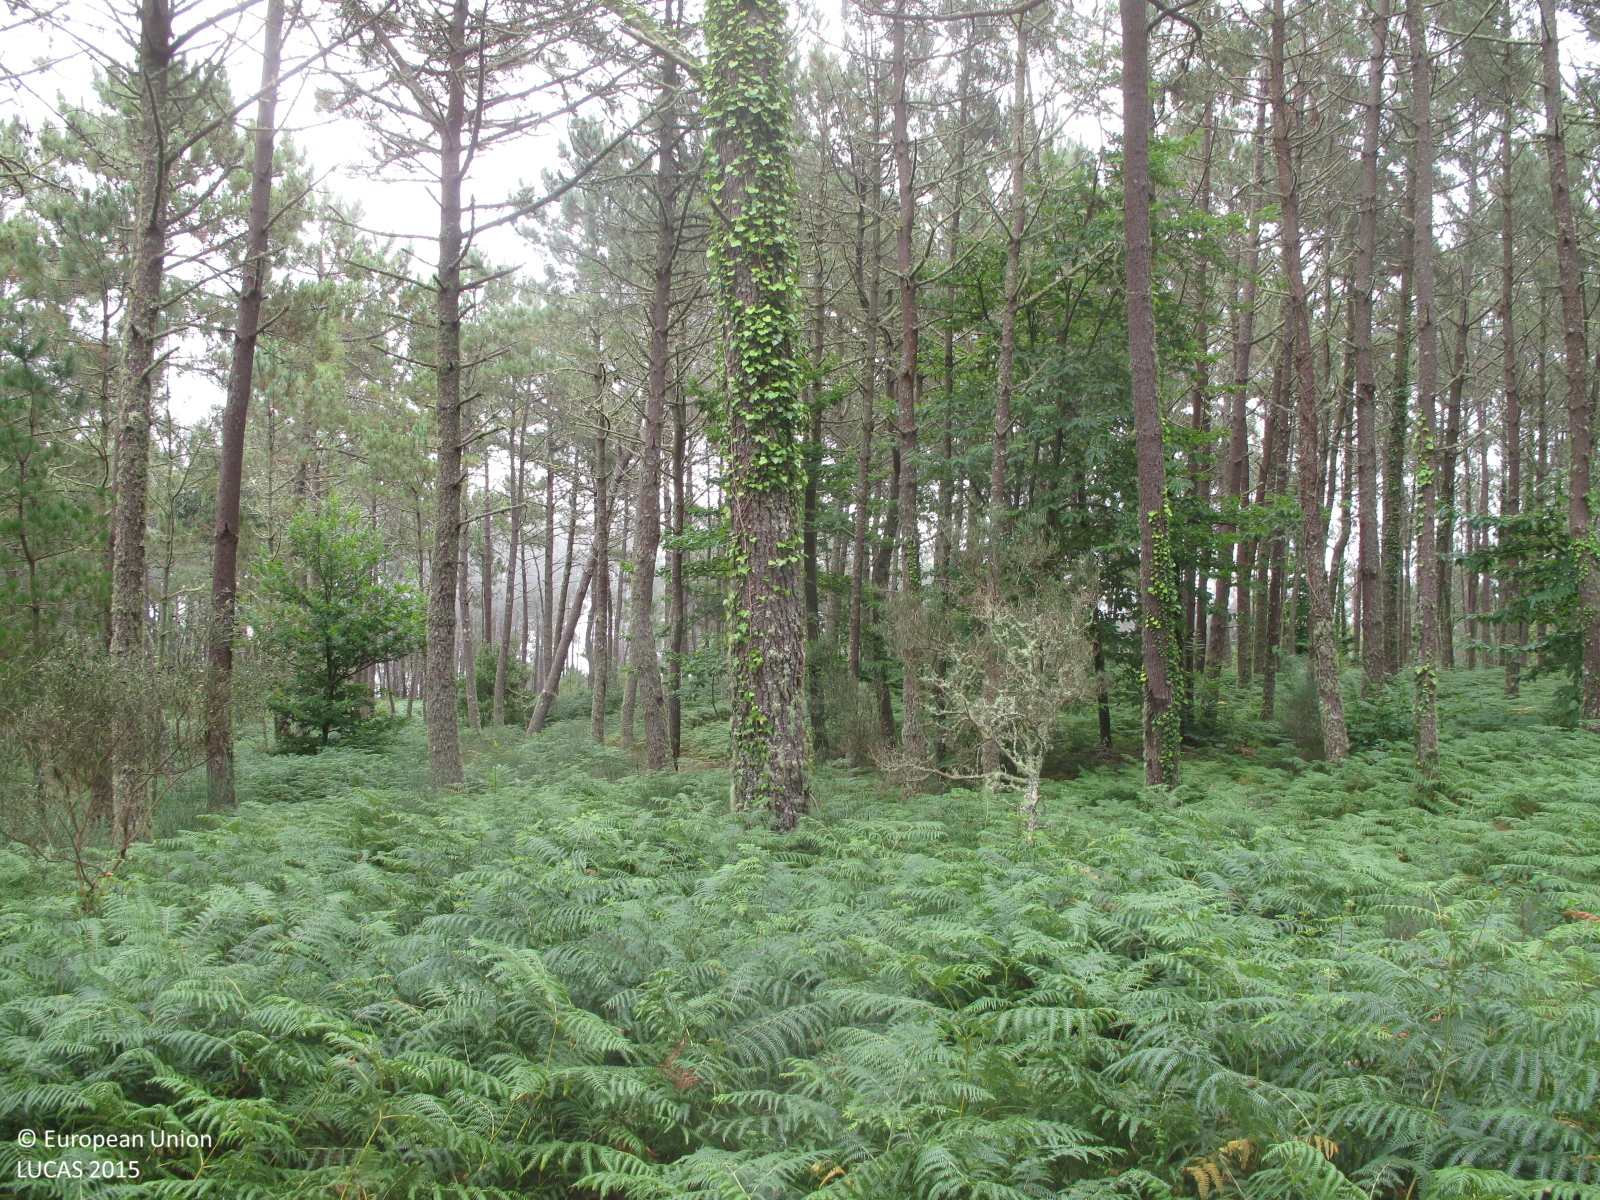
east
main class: Woodland
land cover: Pine dominated coniferous woodland
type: hemiboreal forest and nemoral coniferous forest and mixed broadleaved-coniferous forest
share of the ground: 50 - 75 %
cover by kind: coniferous forest trees 65 %, herbaceous plants 20 %, shrubs 10 %, broadleaved forest trees 5 %
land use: Forestry
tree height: > 5 m
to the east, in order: Pine dominated coniferous woodland; Grassland without tree/shrub cover; Pine dominated coniferous woodland; Shrubland with sparse tree cover; Tracks; Grass margins; Fences; Apple fruit
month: July
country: ES
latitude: 42.9282
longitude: -9.2802
